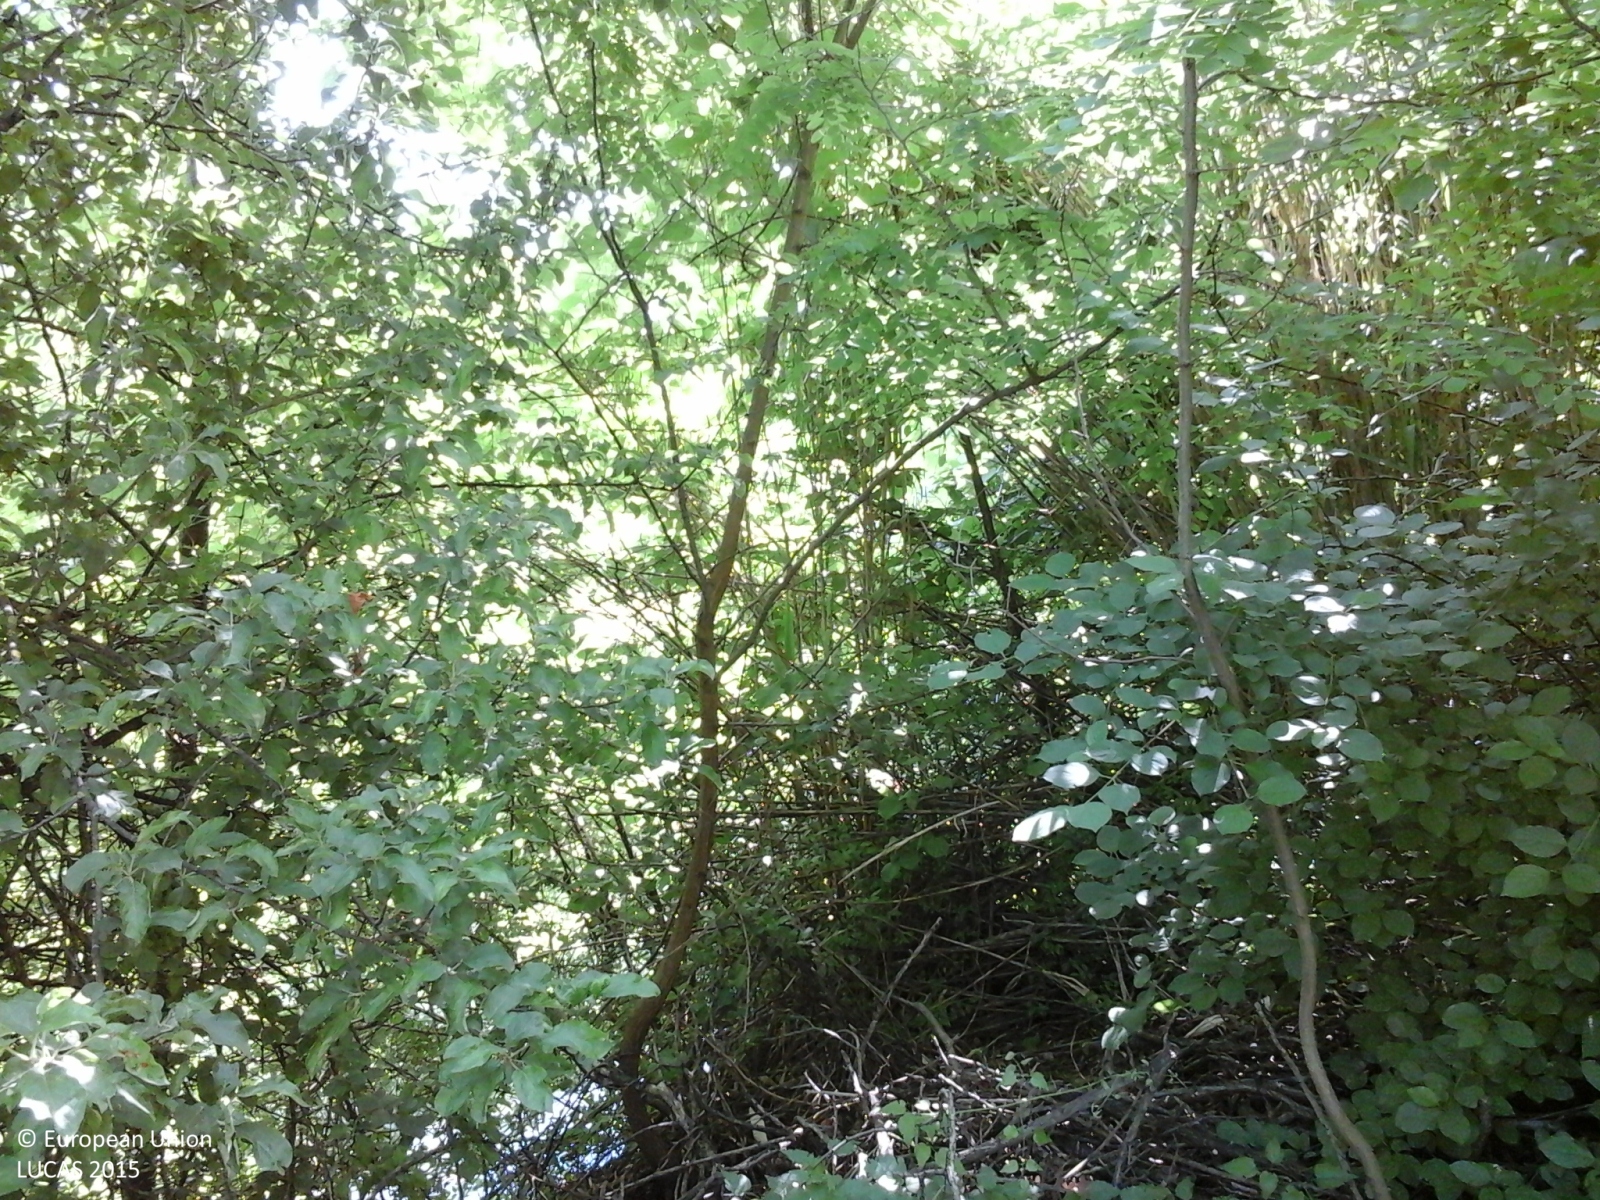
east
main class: Woodland
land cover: Broadleaved woodland
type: mesophytic deciduous forest
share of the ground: > 75 %
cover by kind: broadleaved forest trees 85 %, shrubs 10 %, herbaceous plants 5 %
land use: Forestry
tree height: > 5 m
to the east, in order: Broadleaved woodland; Dry stone walls; Paved roads, cycling and walking lanes; Broadleaved woodland; Electric lines; Broadleaved woodland; Shrubland with sparse tree cover; Electric lines; Shrubland with sparse tree cover; Broadleaved woodland; Dry stone walls; Paved roads, cycling and walking lanes; Broadleaved woodland; Other bare soil; Potatoes; Other bare soil; Tracks; Broadleaved woodland; Inland fresh running water
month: June
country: IT
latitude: 44.6437
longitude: 8.3266
